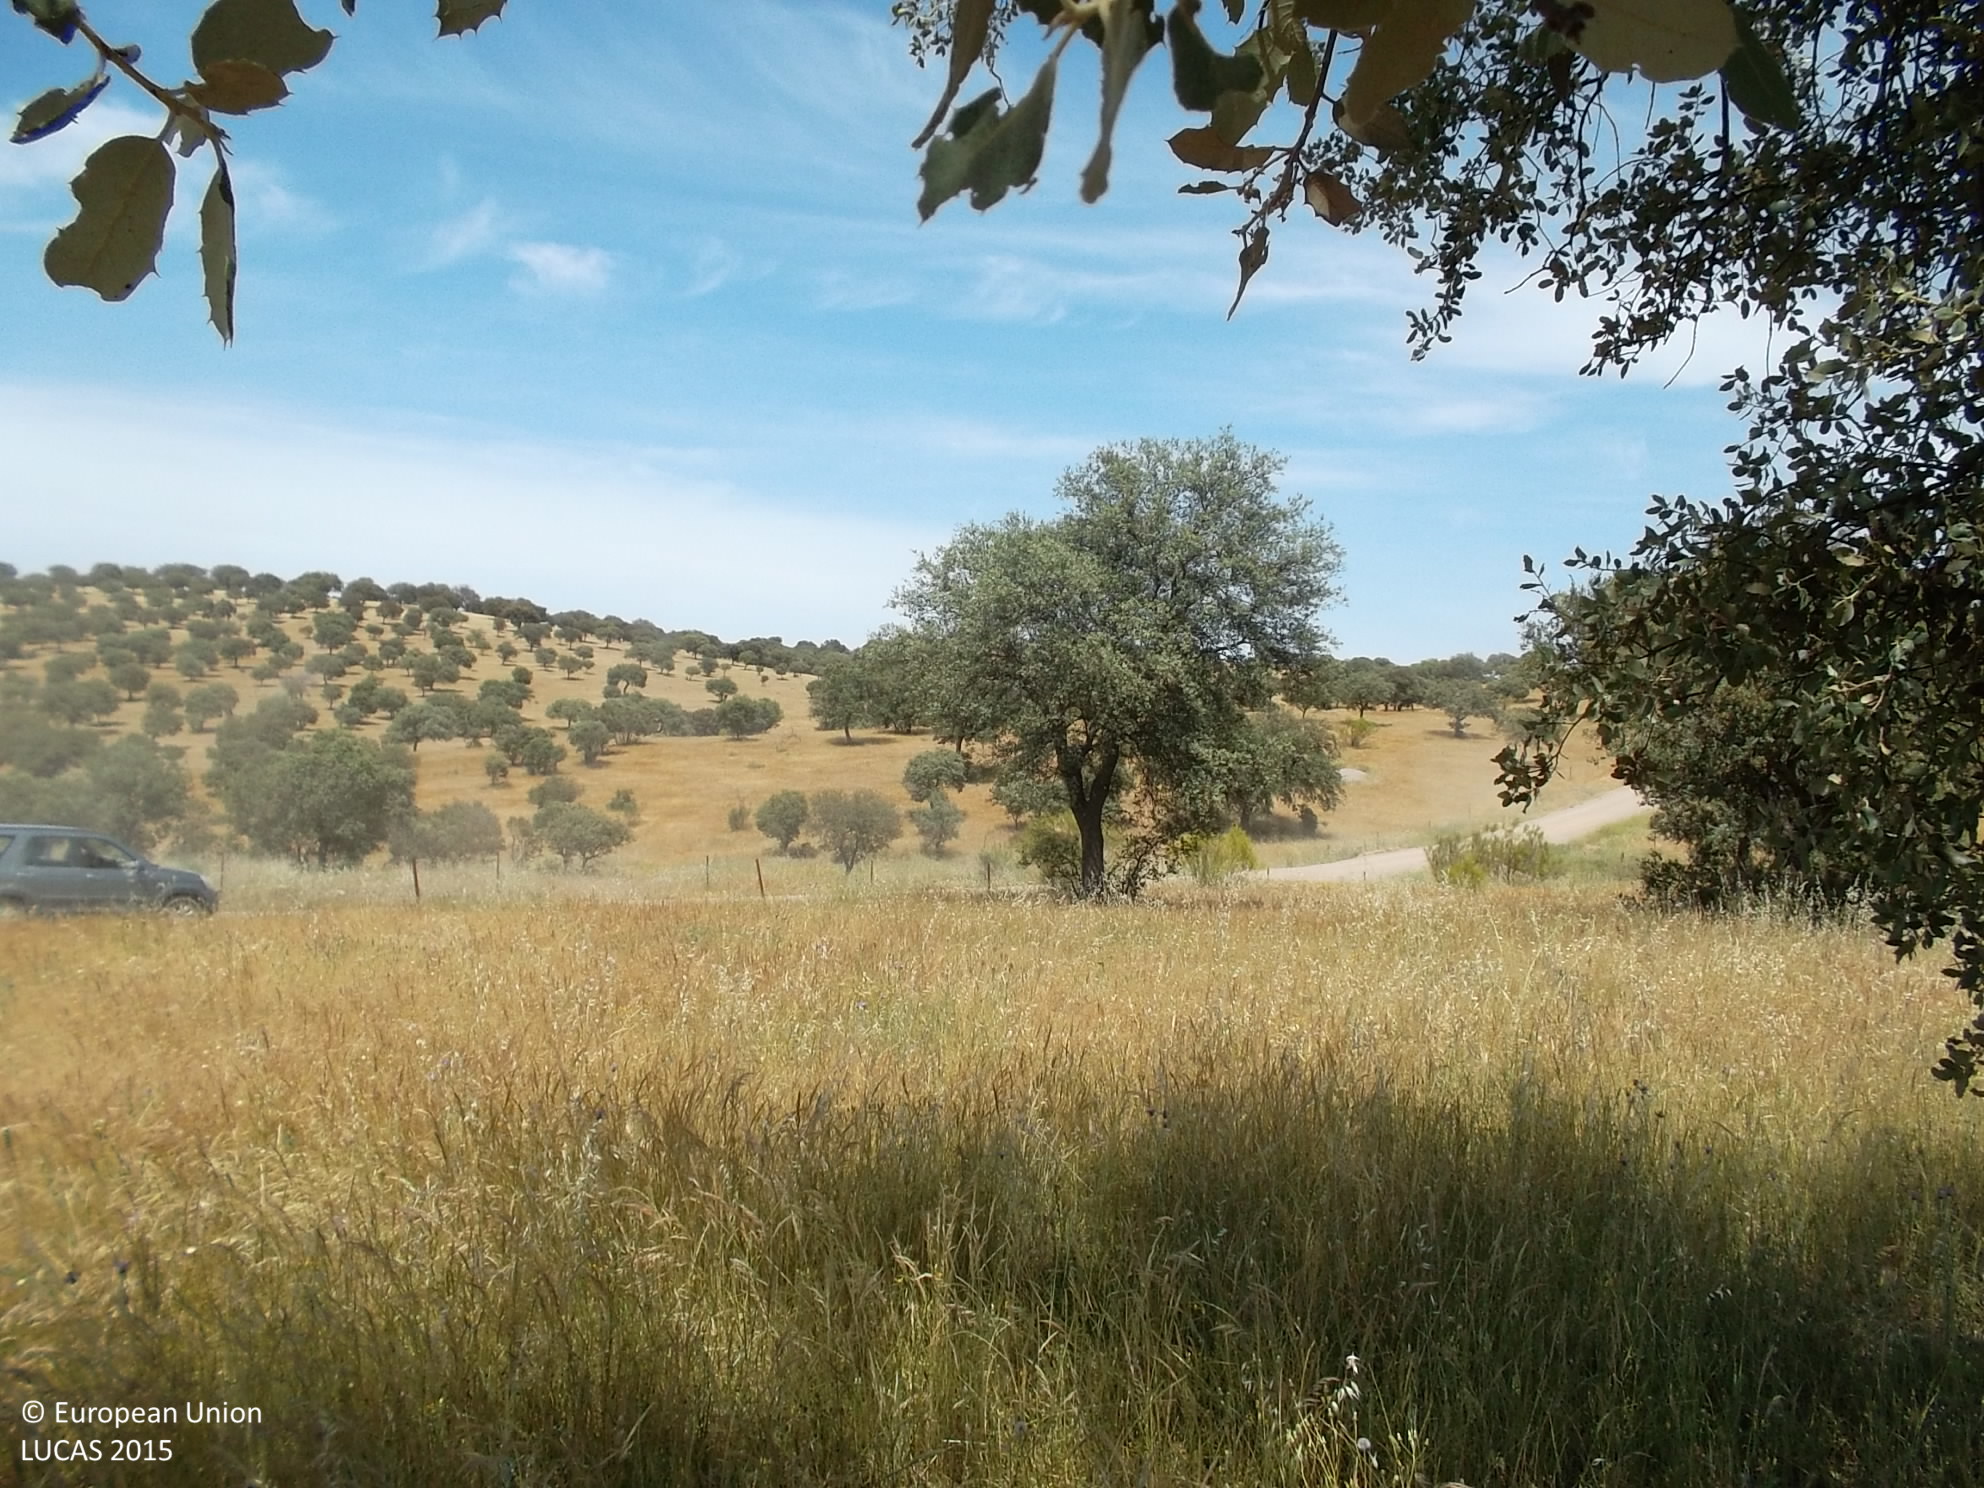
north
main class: Woodland
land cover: Broadleaved woodland
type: broadleaved evergreen forest
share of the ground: 25 - 50 %
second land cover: Spontaneously vegetated surfaces
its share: > 75 %
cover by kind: herbaceous plants 70 %, broadleaved forest trees 30 %
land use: Forestry
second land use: Agriculture (excluding fallow land and kitchen gardens)
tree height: > 5 m
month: May
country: ES
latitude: 38.6967
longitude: -4.8025
